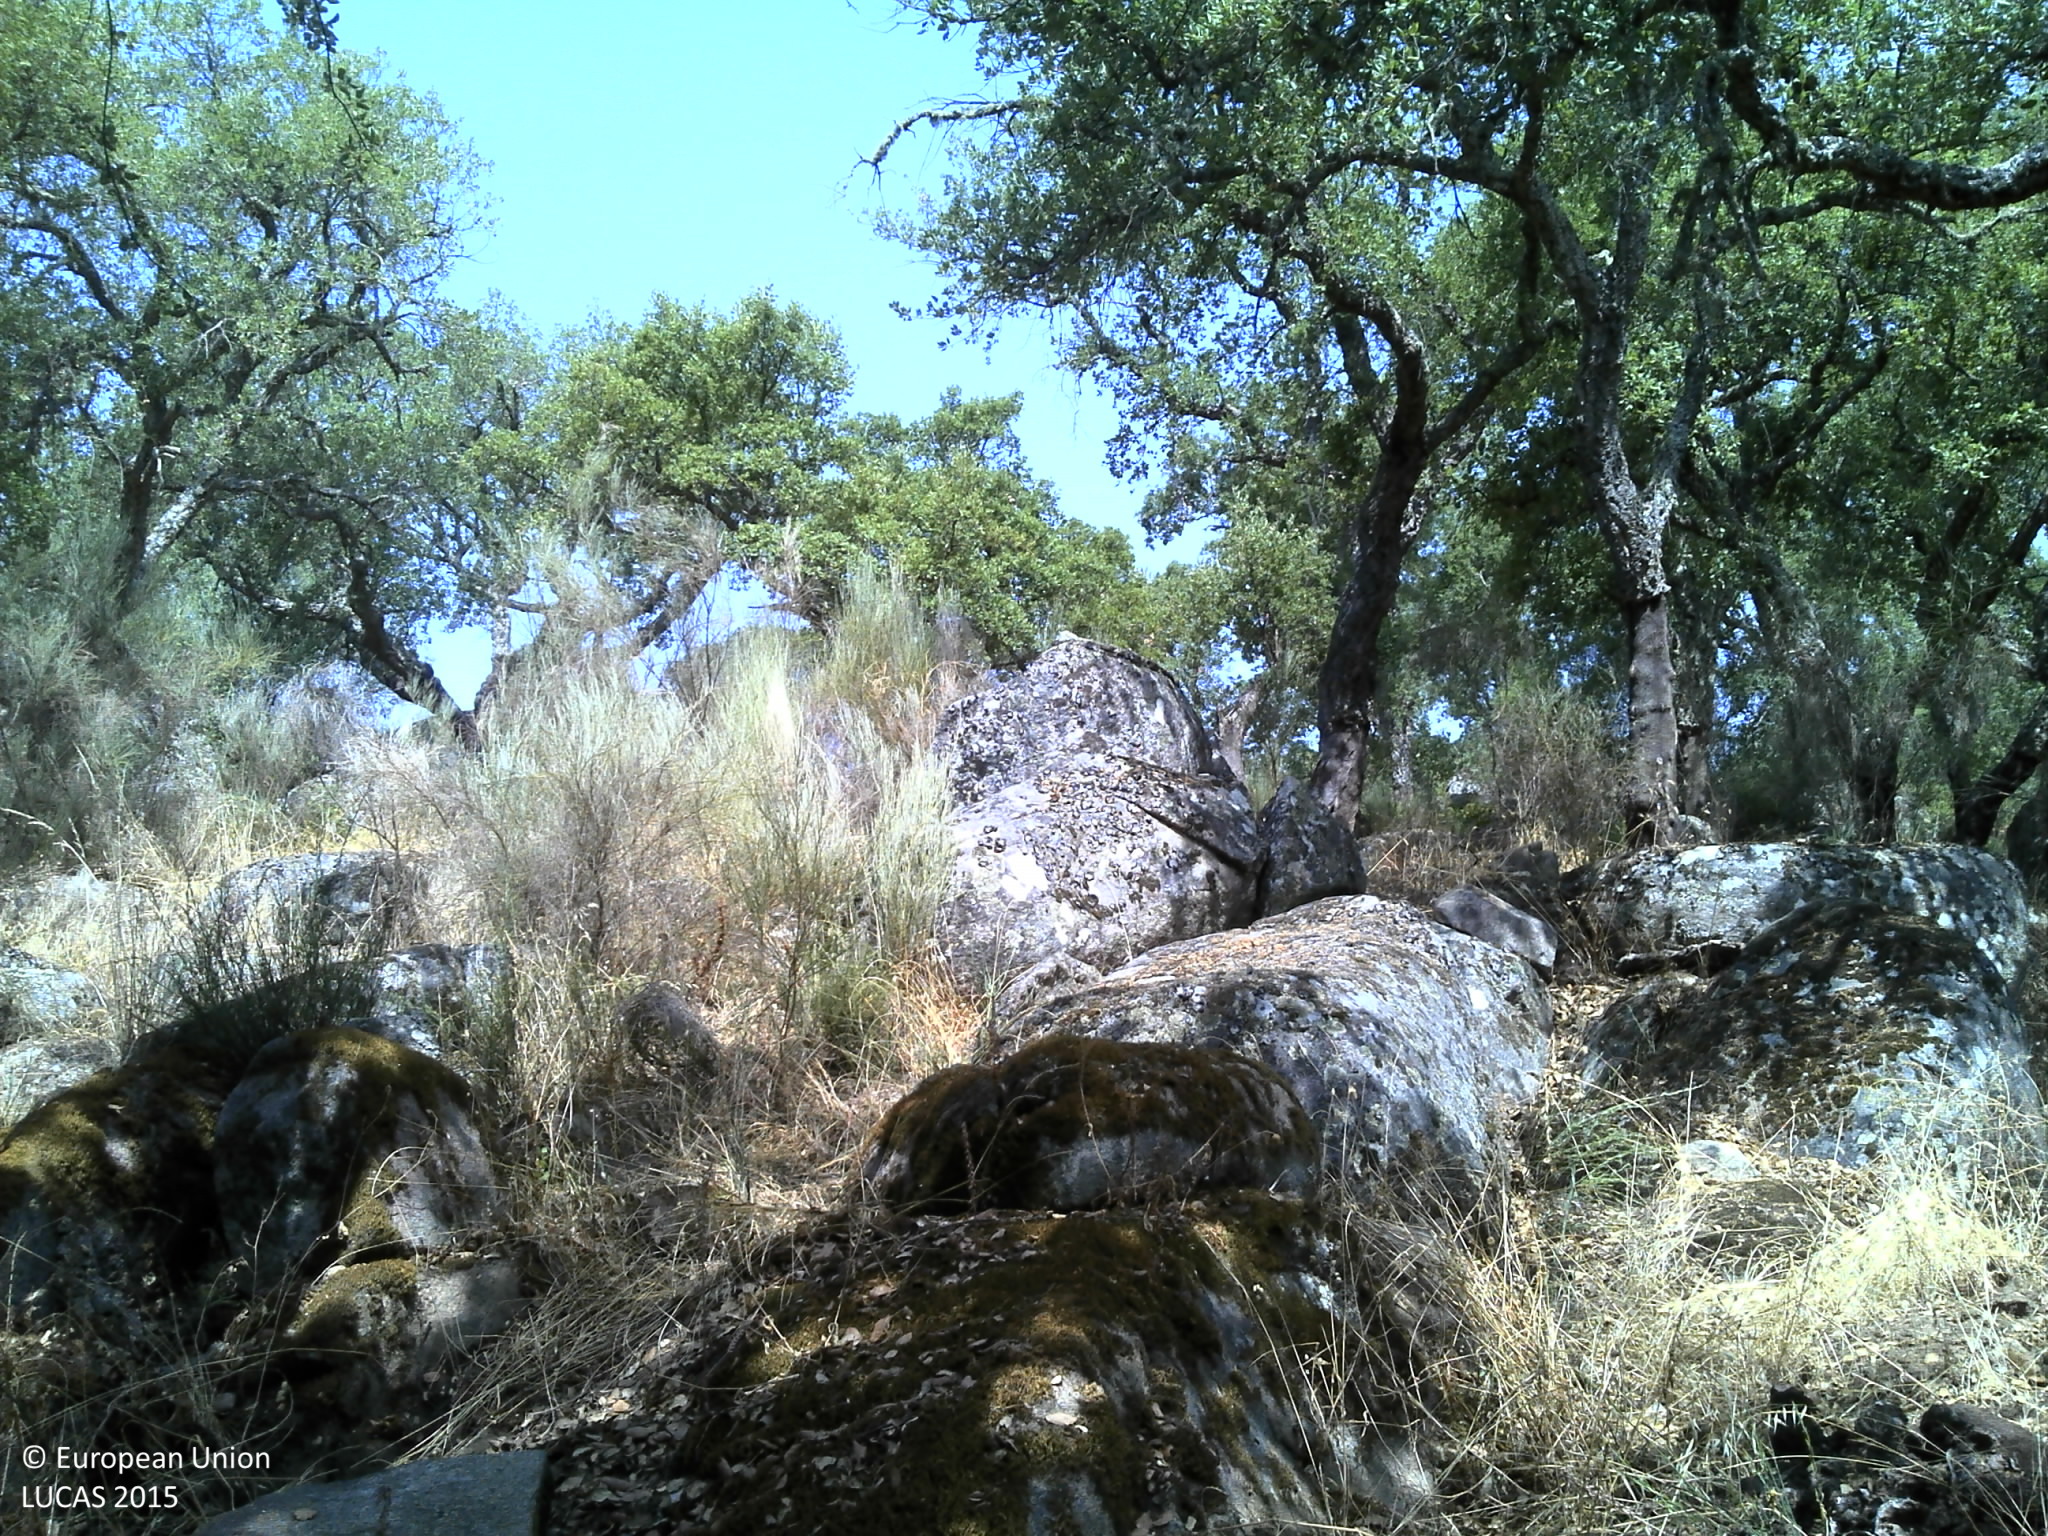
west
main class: Woodland
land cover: Broadleaved woodland
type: broadleaved evergreen forest
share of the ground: 25 - 50 %
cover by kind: broadleaved forest trees 50 %, consolidated bare surface 50 %
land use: Forestry
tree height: > 5 m
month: August
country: PT
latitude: 39.2778
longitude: -7.4650
